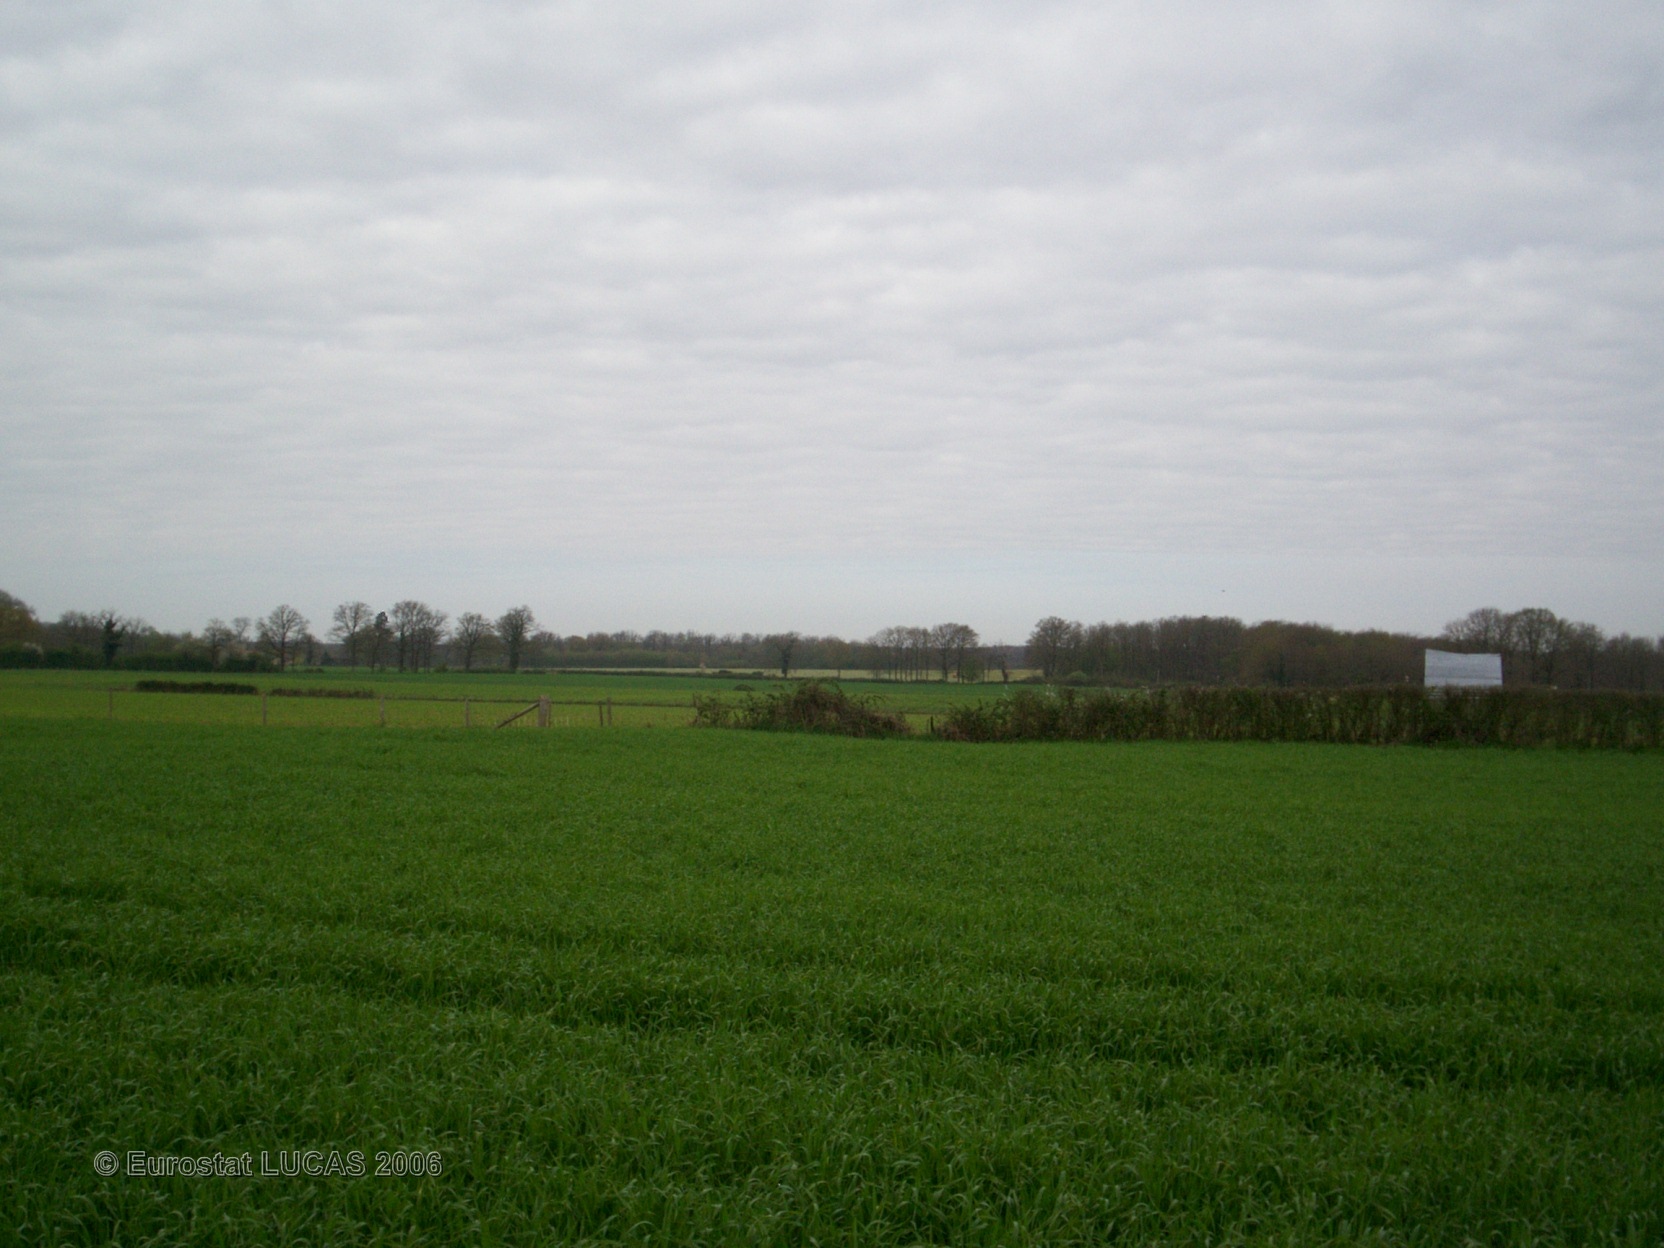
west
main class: Cropland
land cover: Barley
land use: Agriculture (excluding fallow land and kitchen gardens)
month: April
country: FR
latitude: 46.1492
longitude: 0.5459
